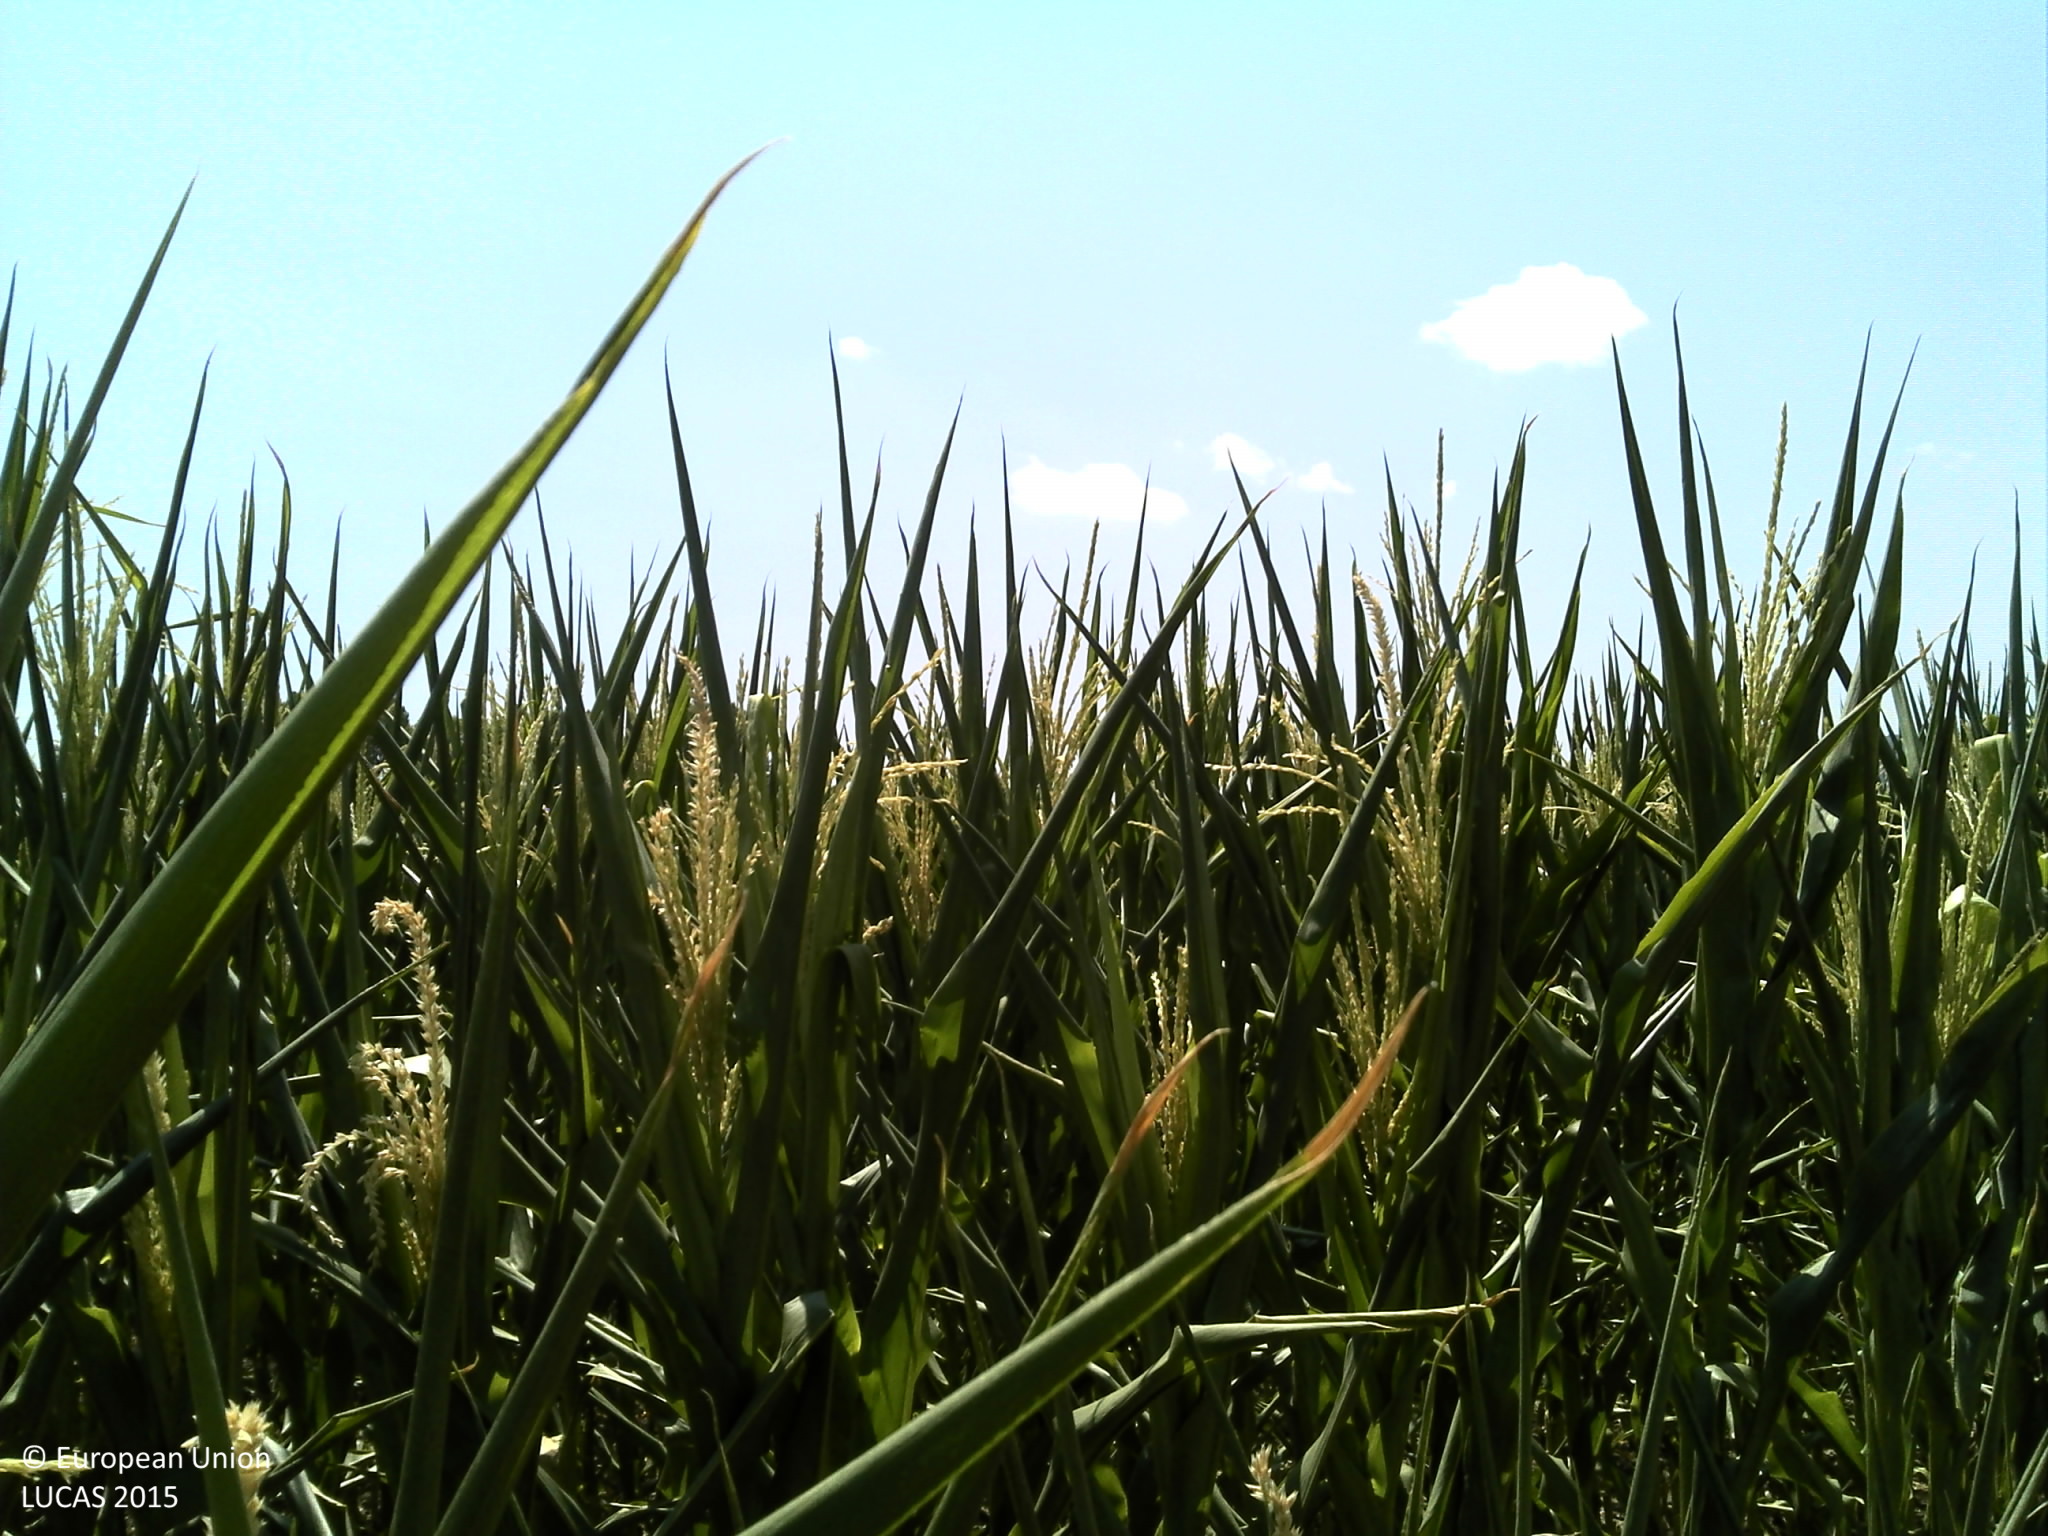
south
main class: Cropland
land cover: Maize
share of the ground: > 75 %
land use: Agriculture (excluding fallow land and kitchen gardens)
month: July
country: FR
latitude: 45.7697
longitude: 3.1460
